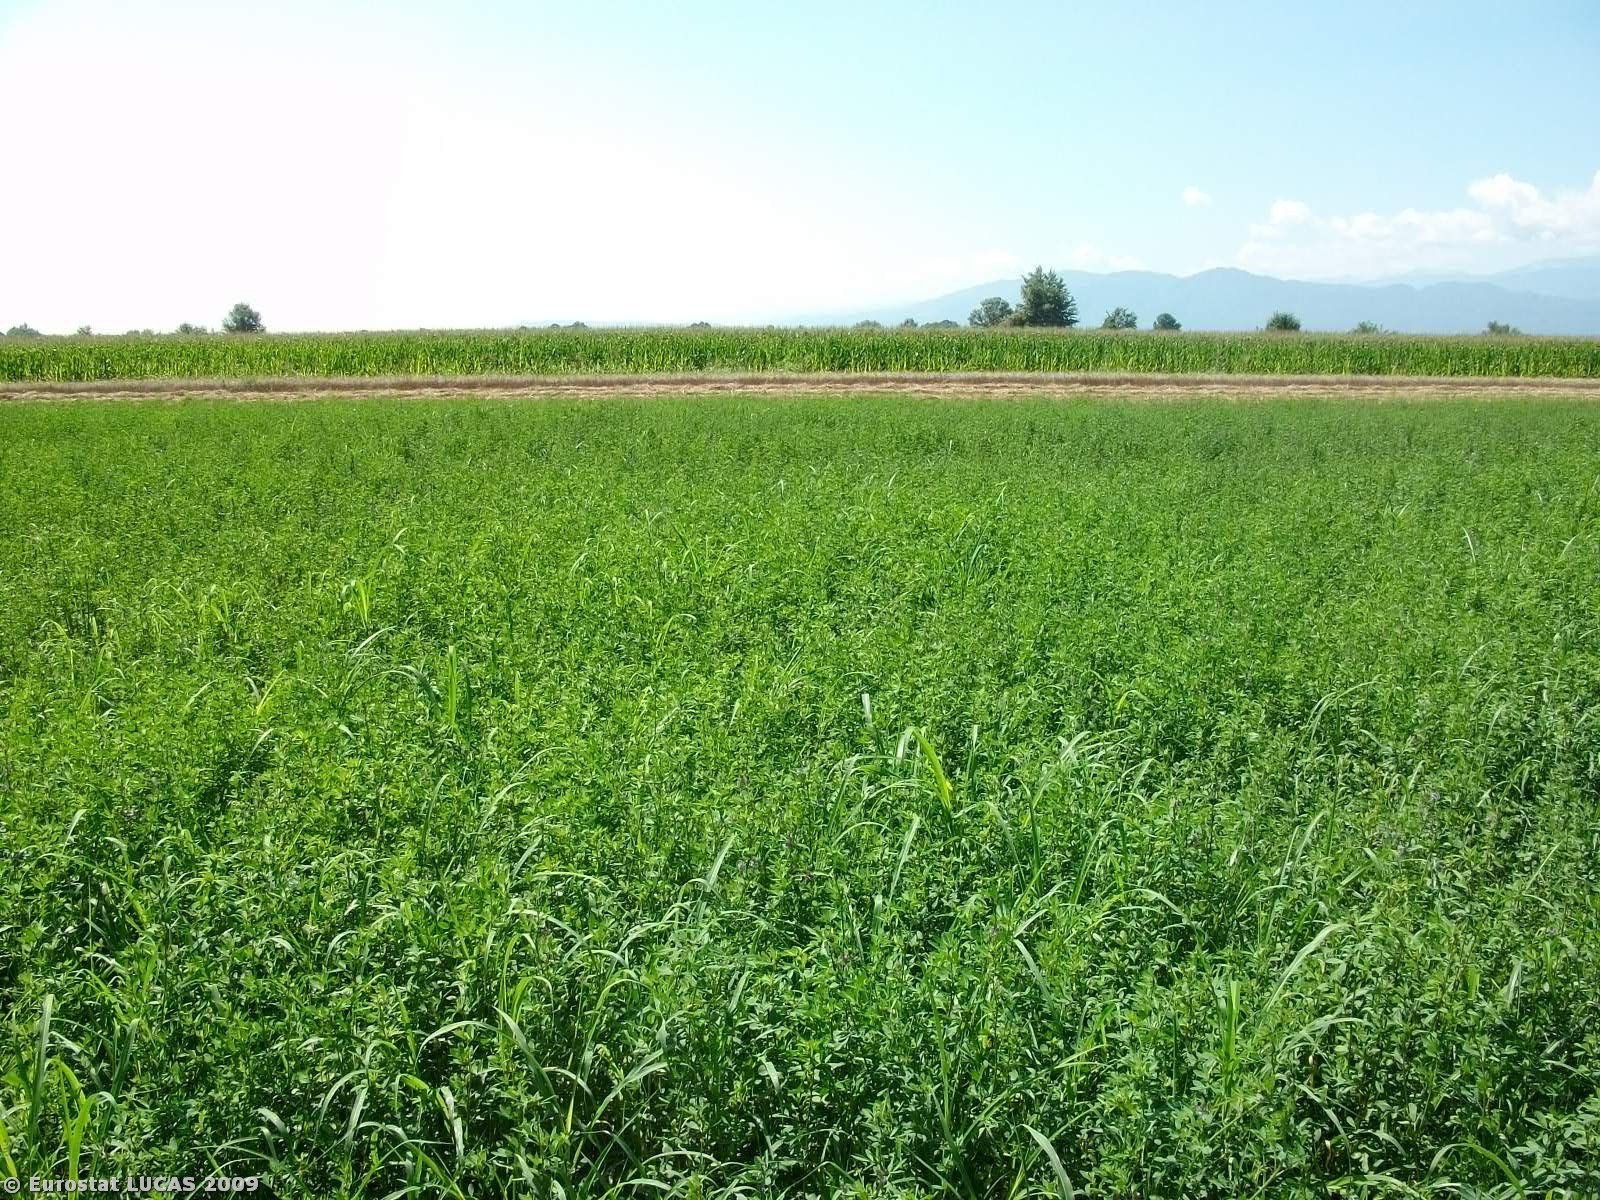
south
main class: Cropland
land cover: Clovers
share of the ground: > 75 %
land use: Agriculture (excluding fallow land and kitchen gardens)
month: July
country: GR
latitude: 39.5285
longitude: 21.6976
